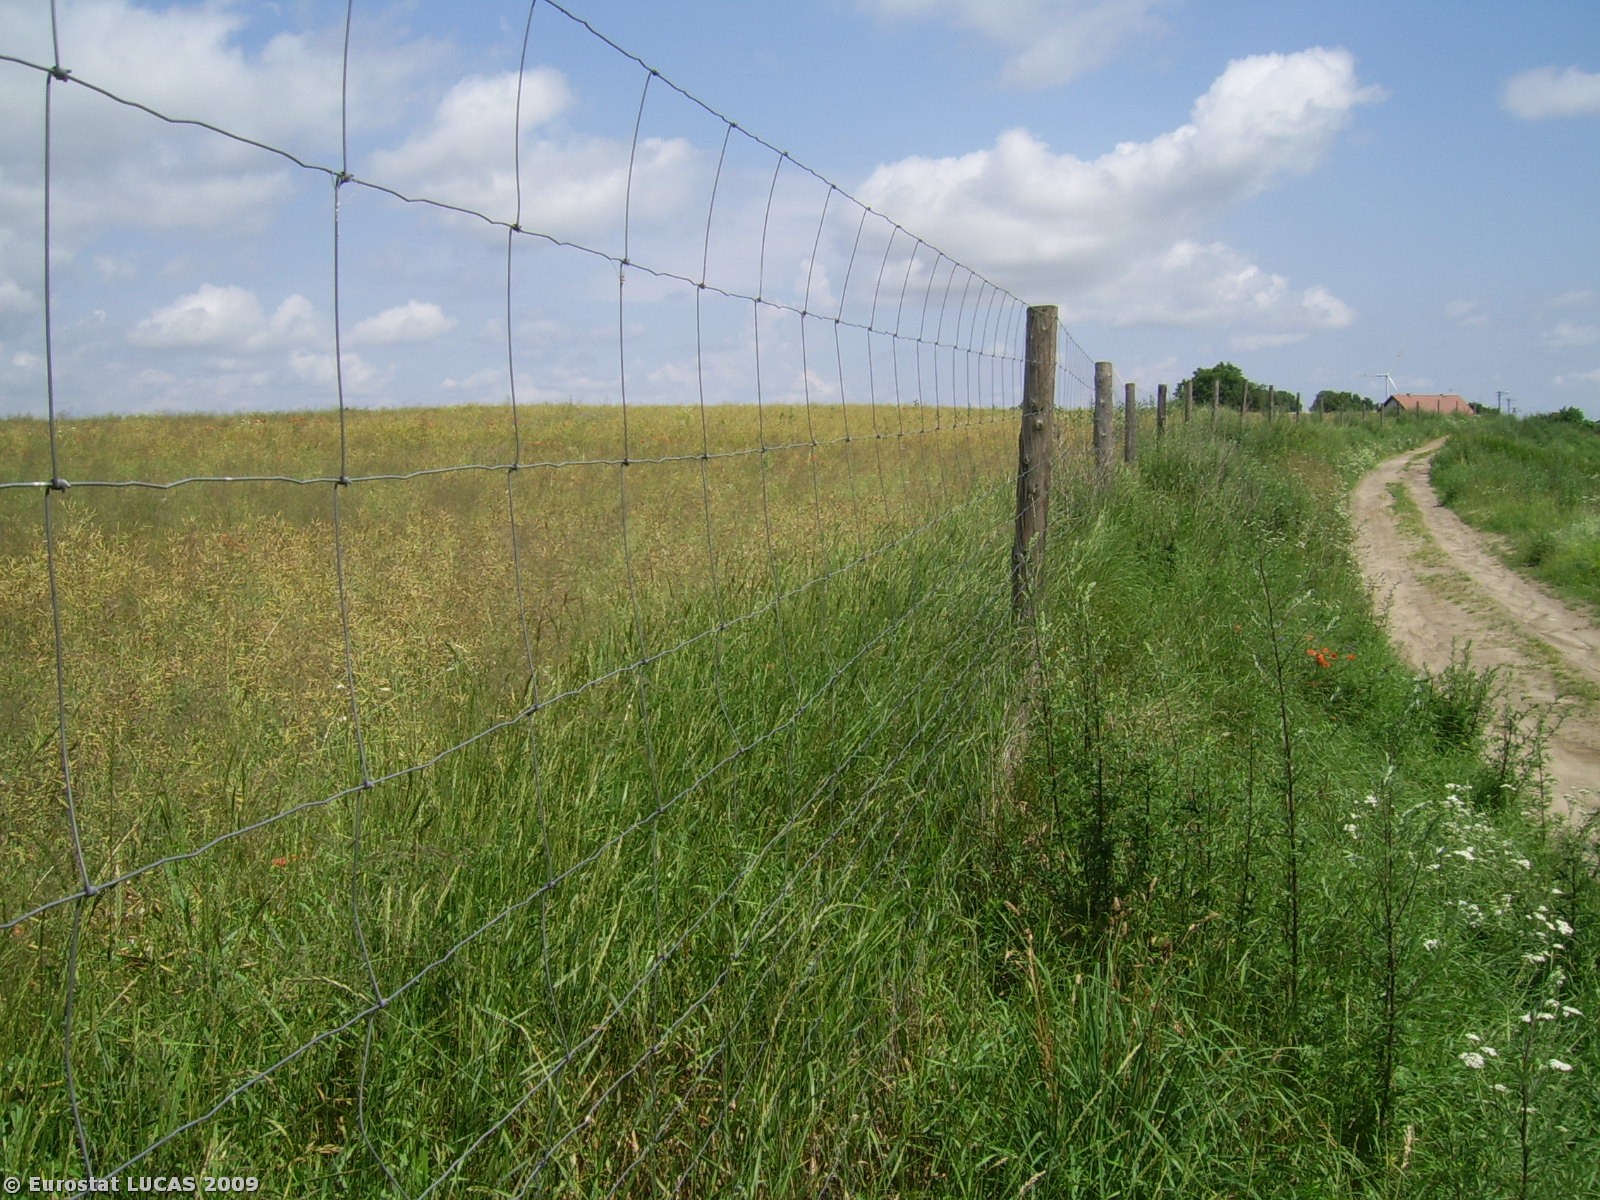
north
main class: Woodland
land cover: Broadleaved woodland
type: mesophytic deciduous forest
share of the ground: > 75 %
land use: Nature reserves
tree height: > 5 m
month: July
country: PL
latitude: 52.6048
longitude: 18.1228
